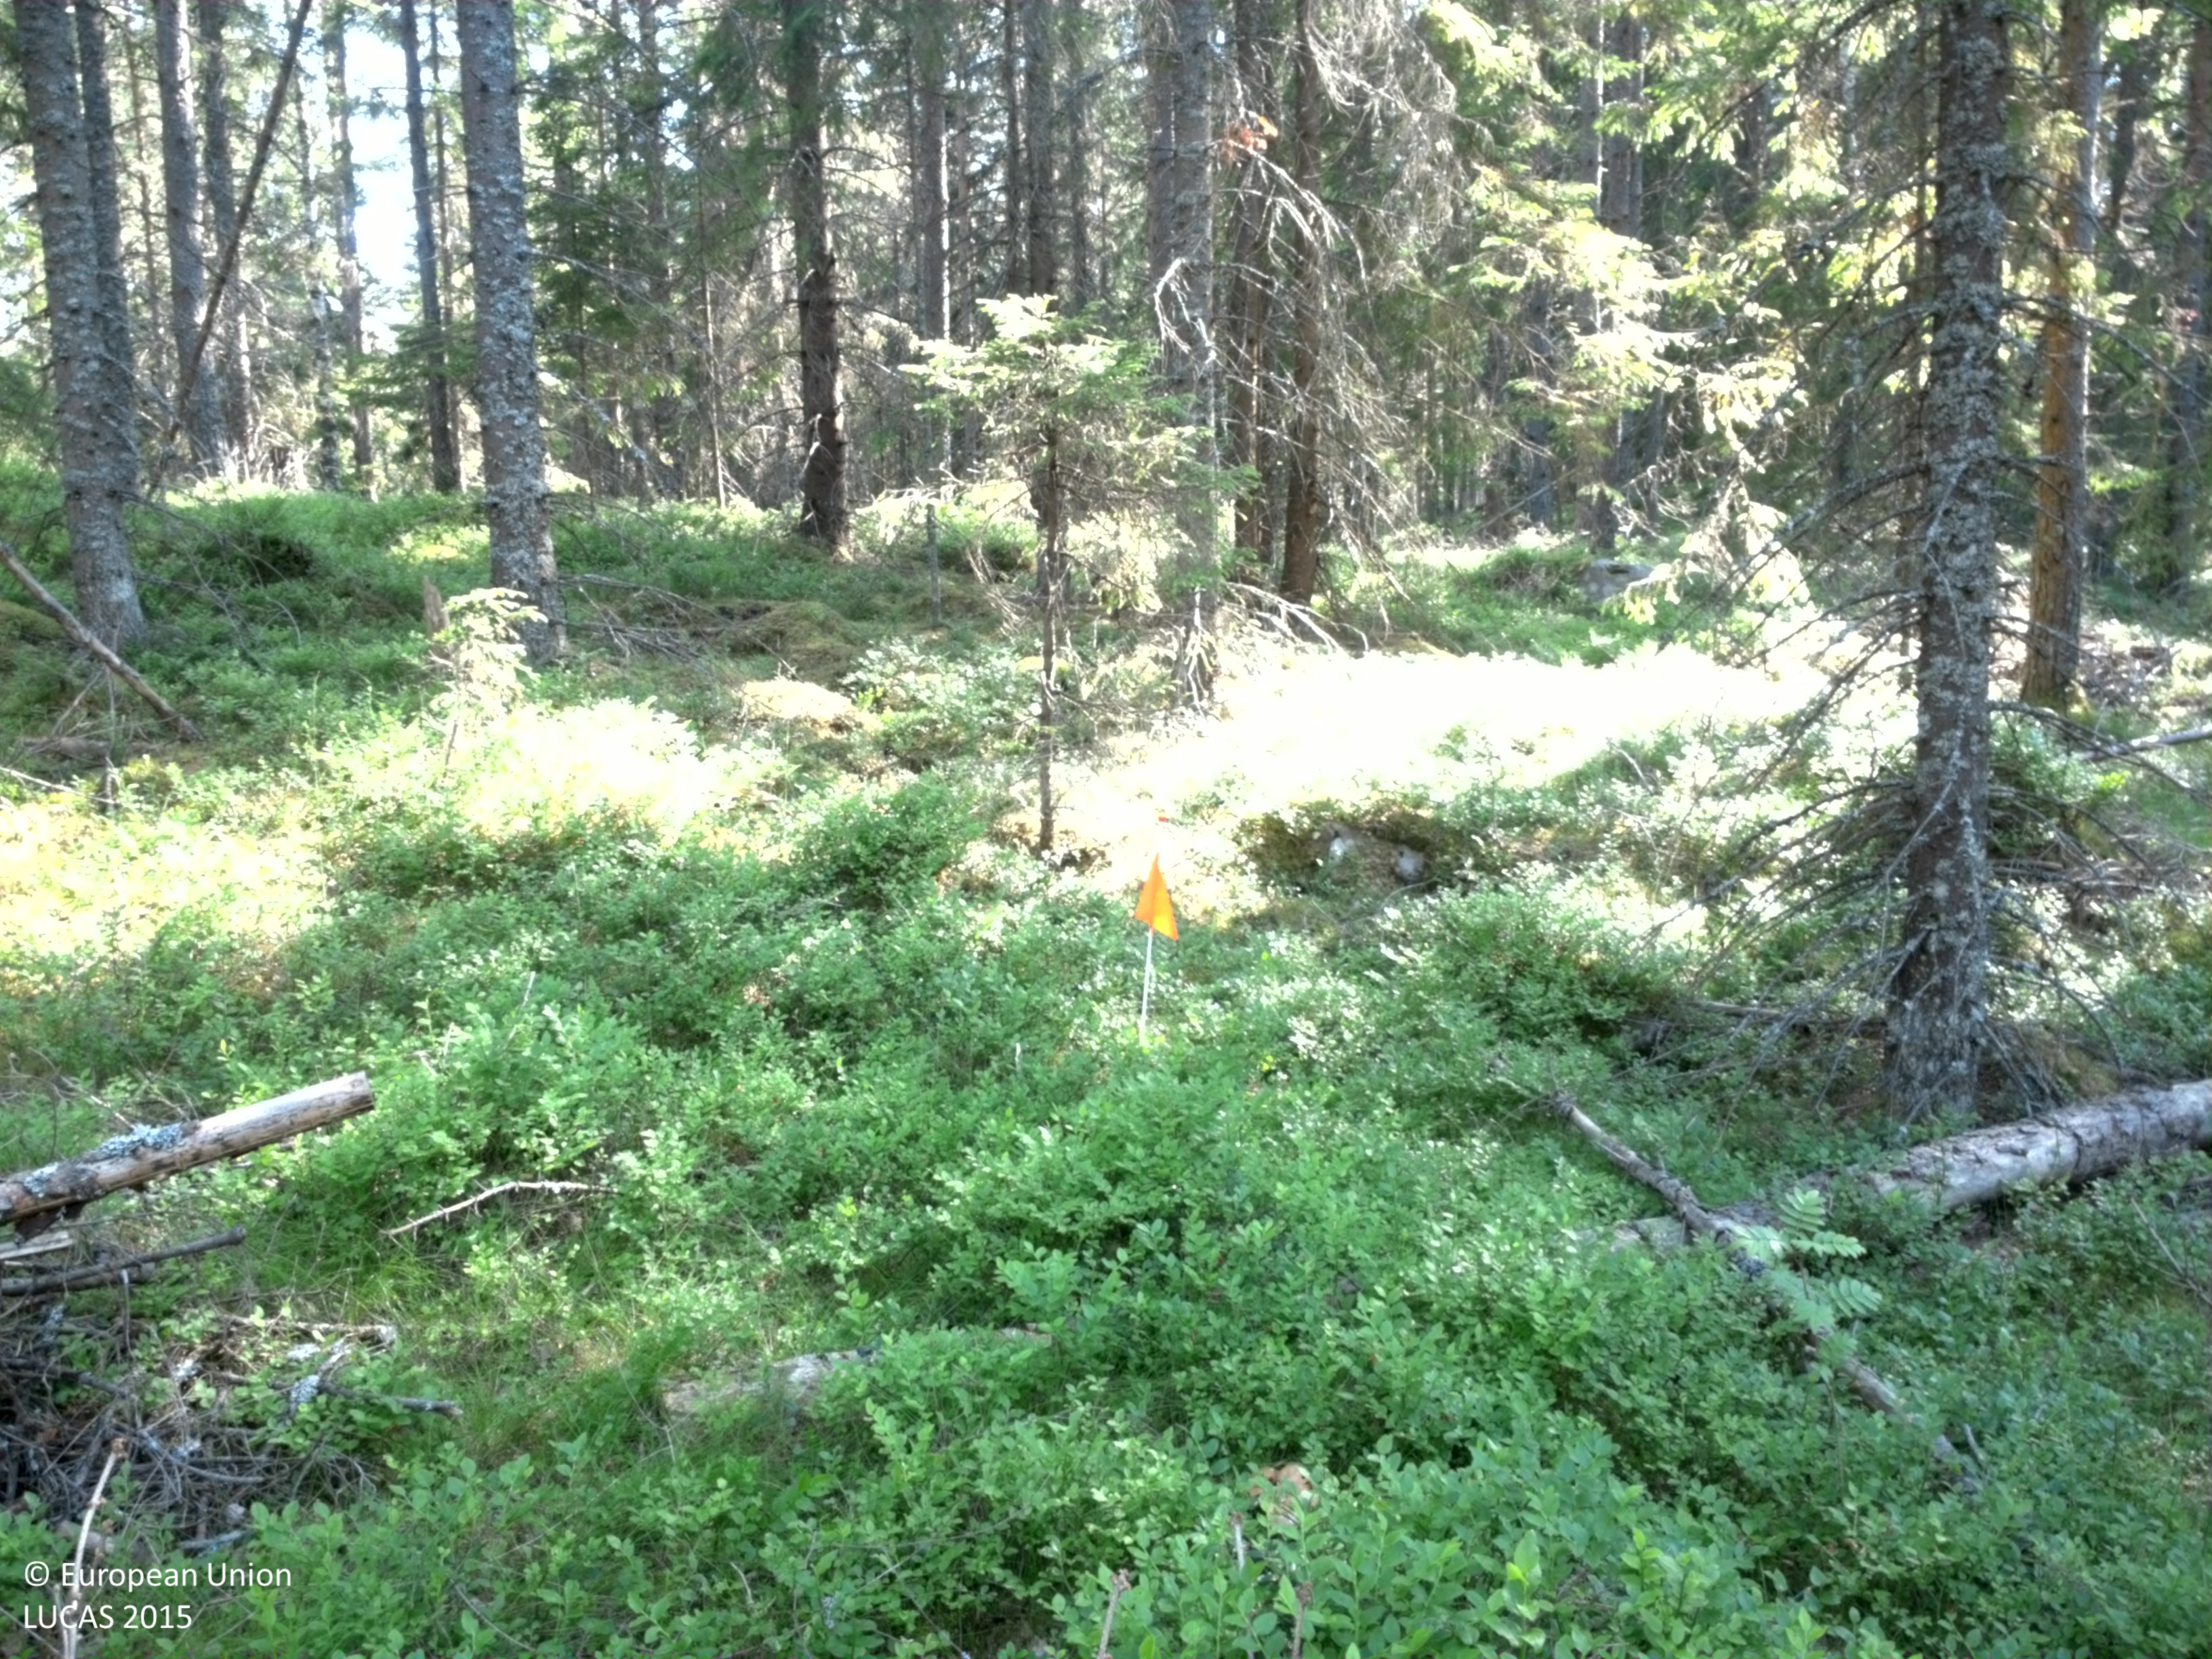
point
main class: Woodland
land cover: Pine dominated mixed woodland
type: boreal forest
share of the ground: 50 - 75 %
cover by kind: coniferous forest trees 40 %, shrubs 30 %, broadleaved forest trees 20 %, herbaceous plants 5 %, consolidated bare surface 5 %
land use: Forestry
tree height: > 5 m
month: July
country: SE
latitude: 59.1695
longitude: 14.5576
